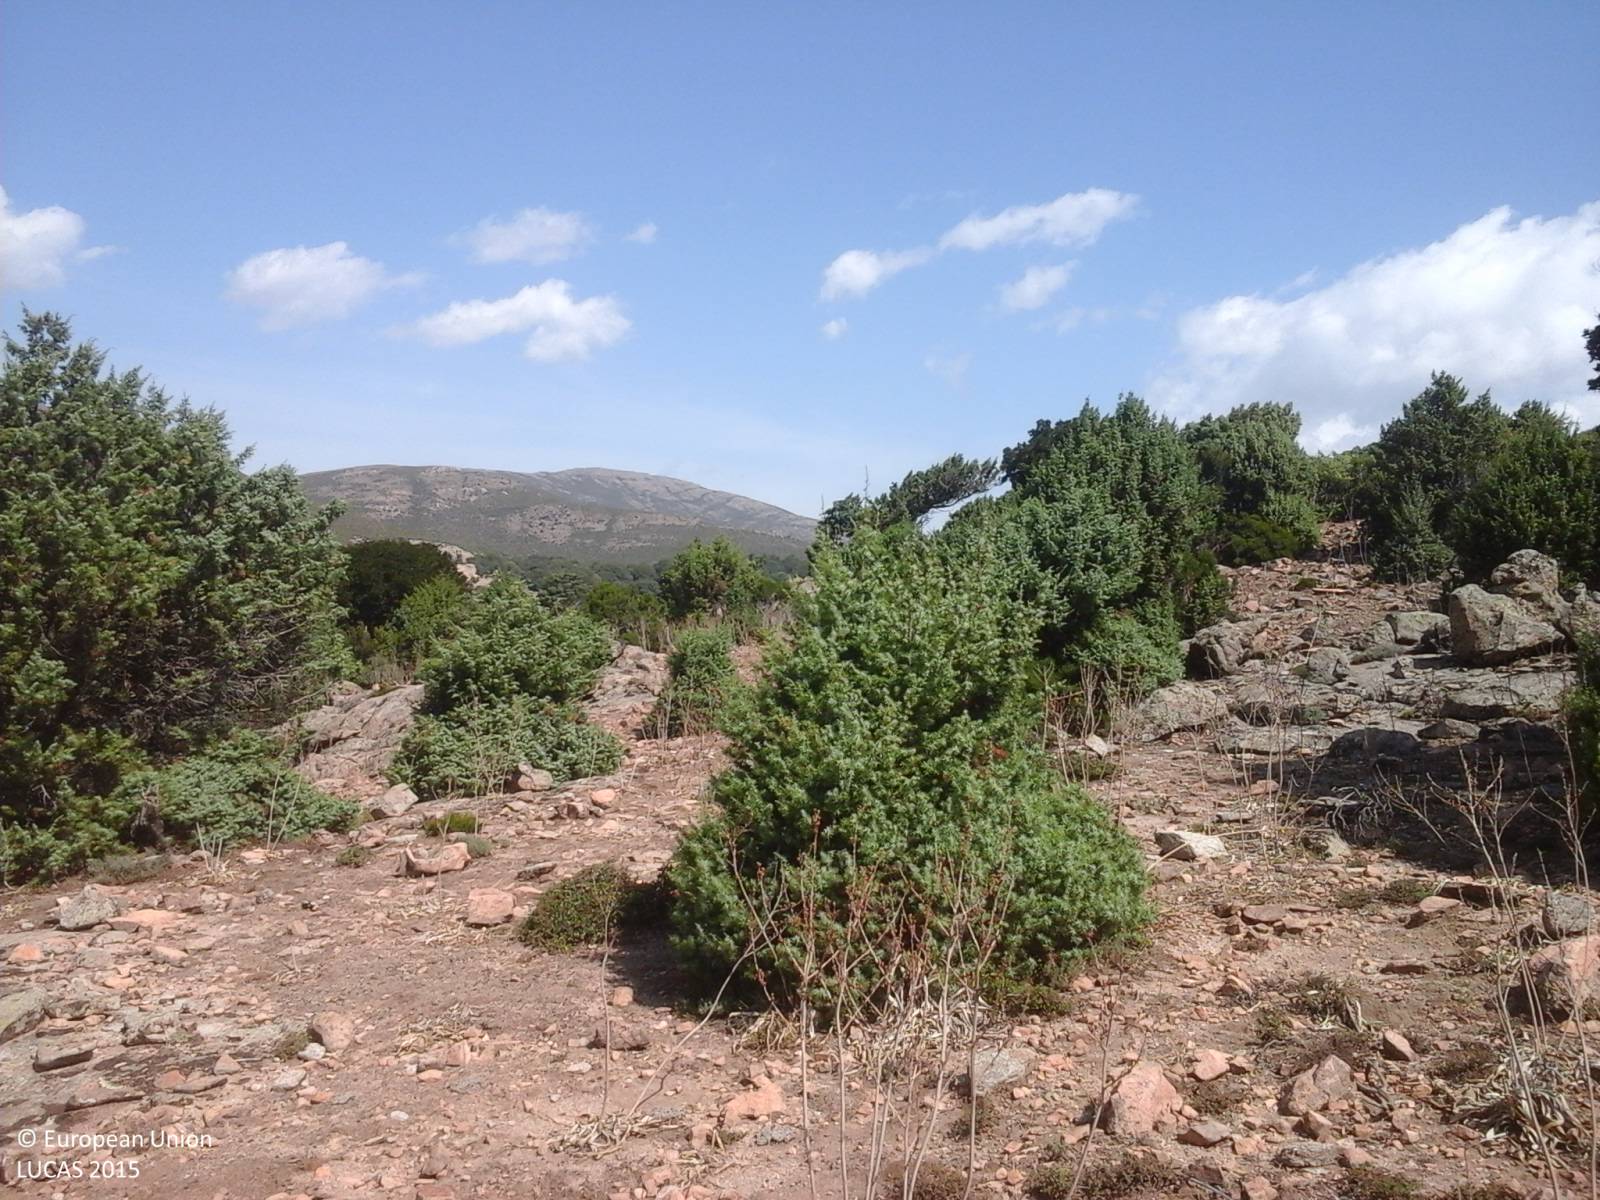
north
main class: Shrubland
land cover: Shrubland with sparse tree cover
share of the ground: > 75 %
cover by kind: shrubs 45 %, consolidated bare surface 25 %, unconsolidated bare surface 20 %, coniferous forest trees 5 %, herbaceous plants 5 %
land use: Agriculture (excluding fallow land and kitchen gardens)
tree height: > 5 m
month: September
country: IT
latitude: 40.0122
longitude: 9.4291
